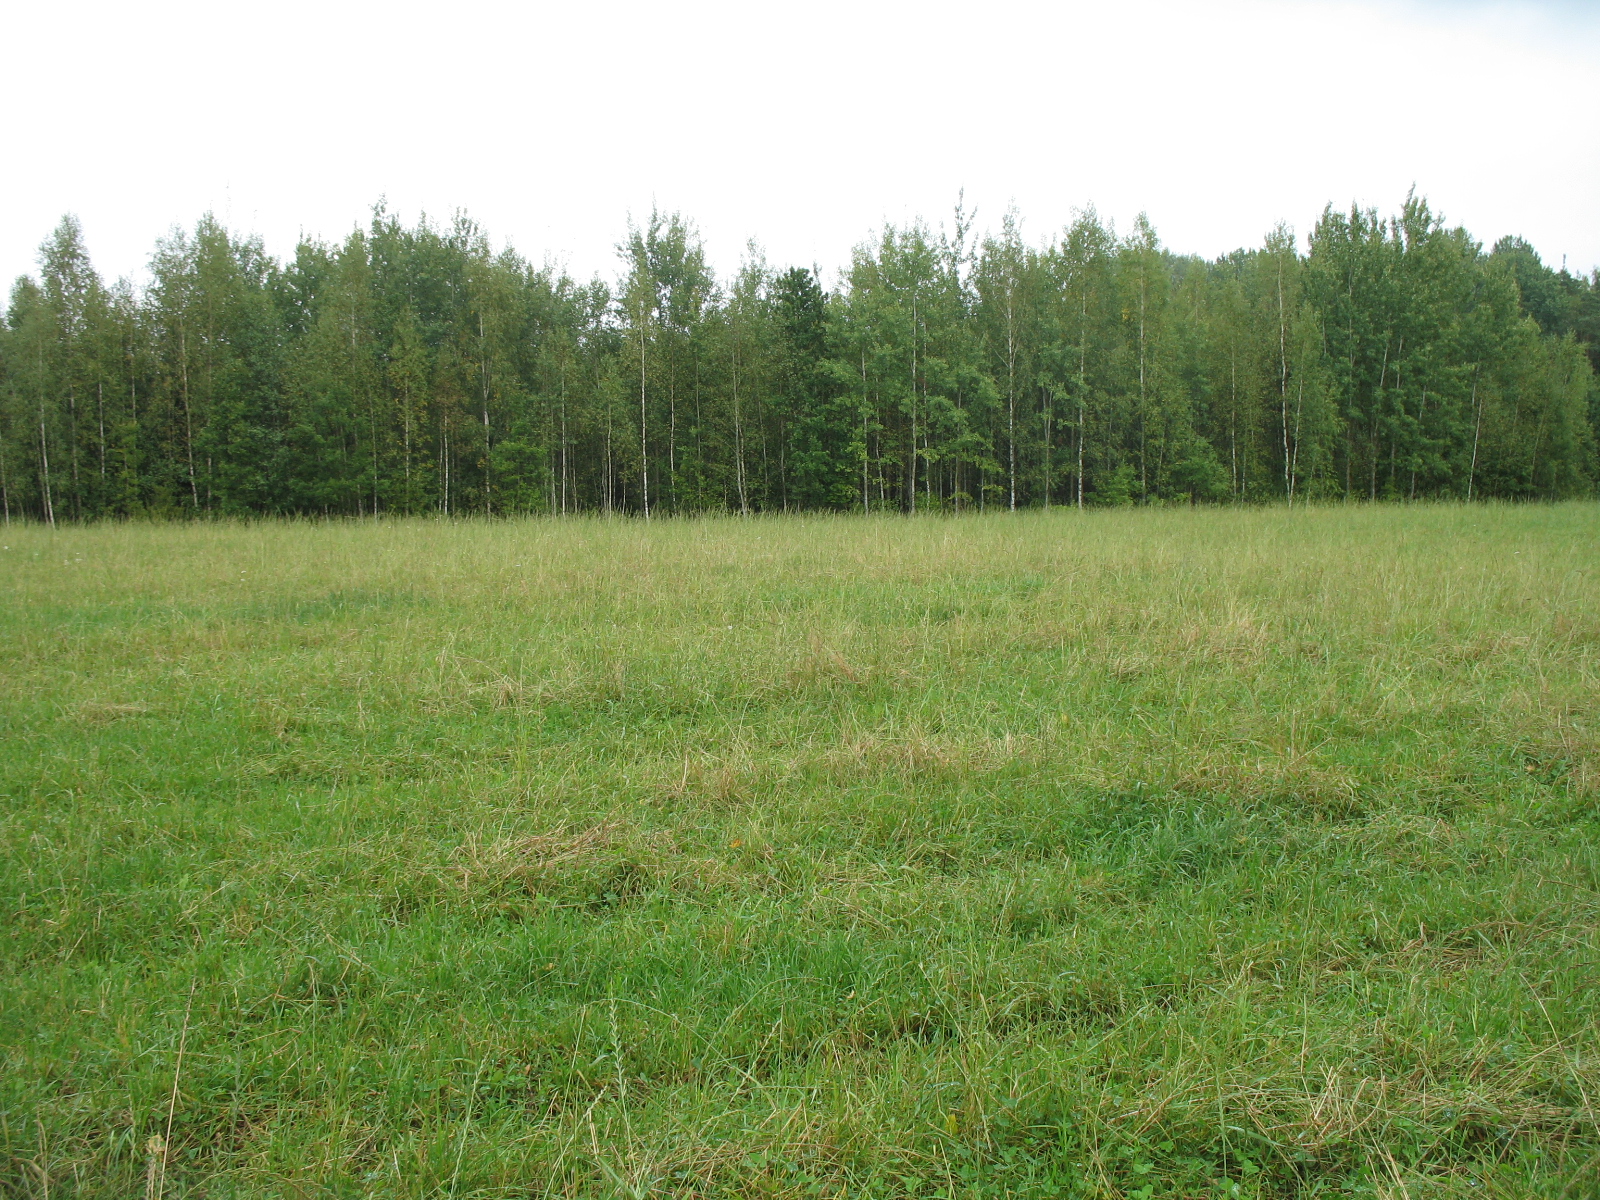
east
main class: Grassland
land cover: Grassland with sparse tree/shrub cover
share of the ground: > 75 %
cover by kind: herbaceous plants 95 %, broadleaved forest trees 5 %
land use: Agriculture (excluding fallow land and kitchen gardens)
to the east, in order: Grassland with sparse tree/shrub cover; Grassland without tree/shrub cover; Broadleaved woodland; Pine dominated mixed woodland; Ditches and canals; Pine dominated mixed woodland; Spruce dominated mixed woodland
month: September
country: LV
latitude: 56.0698
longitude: 25.8910
